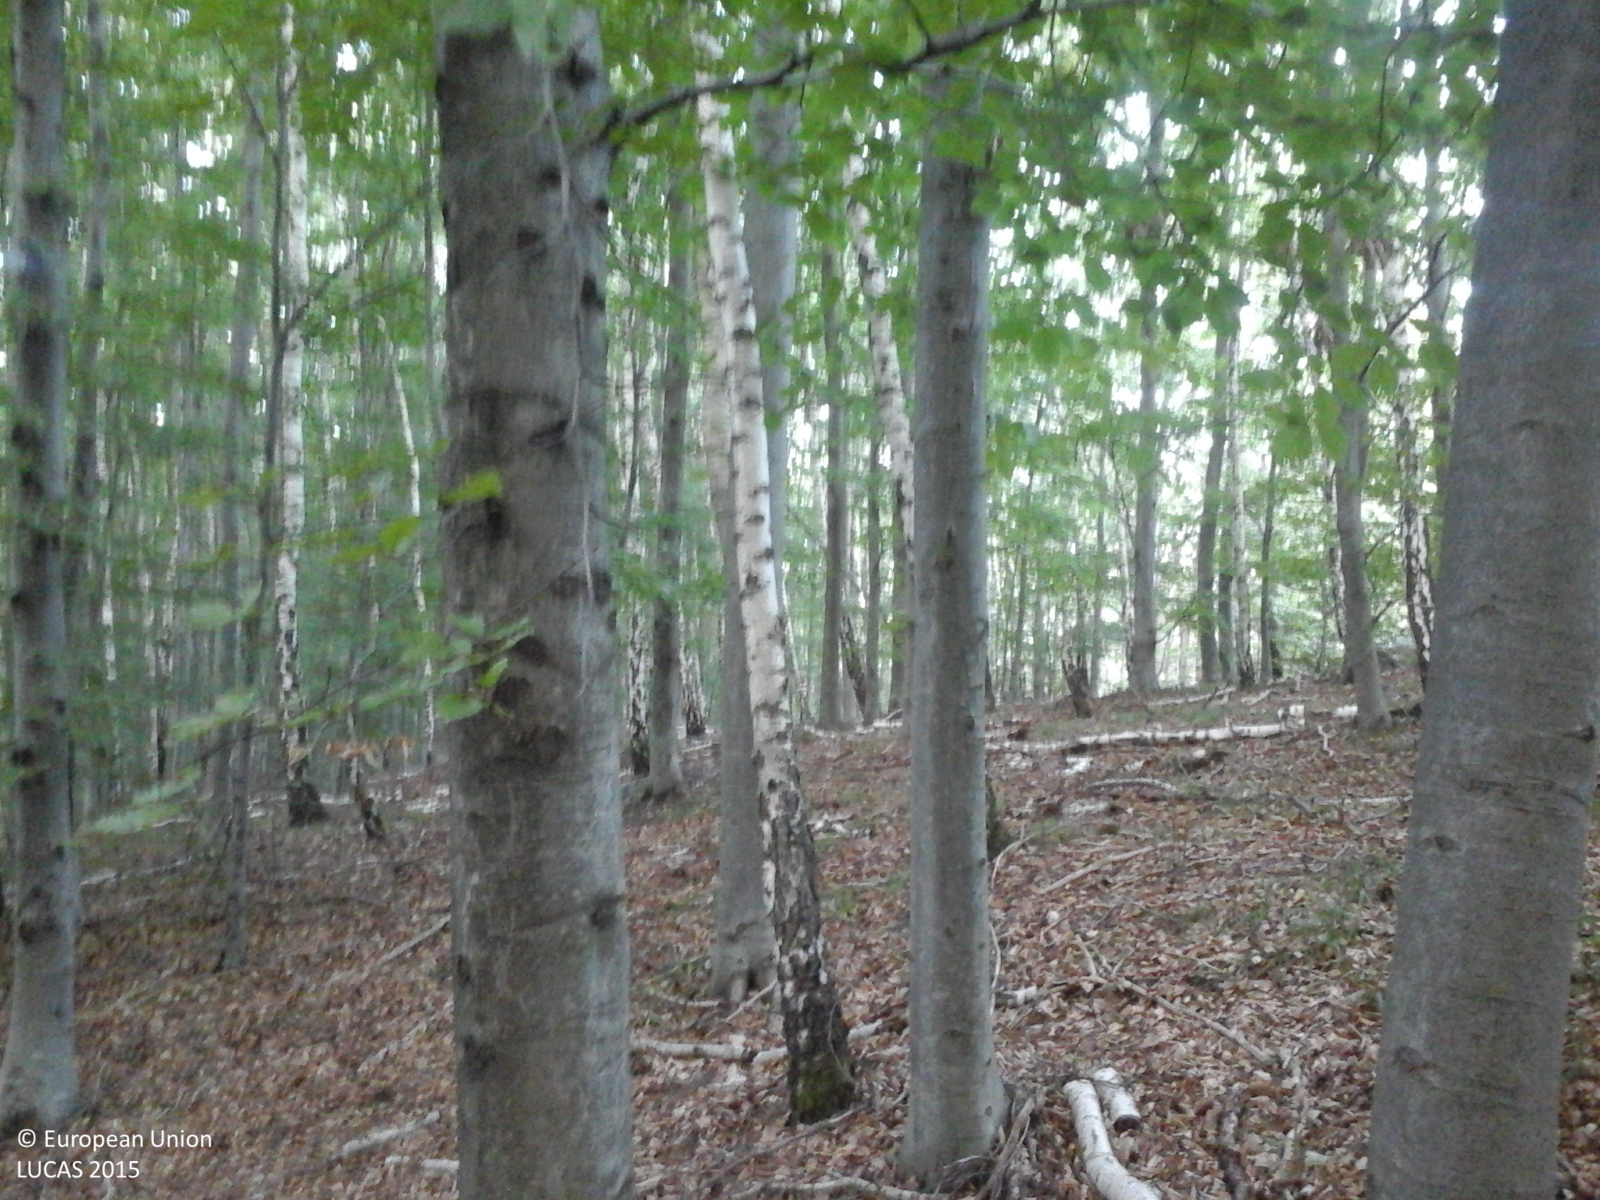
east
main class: Woodland
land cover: Broadleaved woodland
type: beech forest
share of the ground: > 75 %
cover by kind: broadleaved forest trees 100 %
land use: Forestry
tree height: > 5 m
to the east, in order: Broadleaved woodland; Tracks; Broadleaved woodland; Tracks; Broadleaved woodland
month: September
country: RO
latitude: 47.0951
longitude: 22.6118
